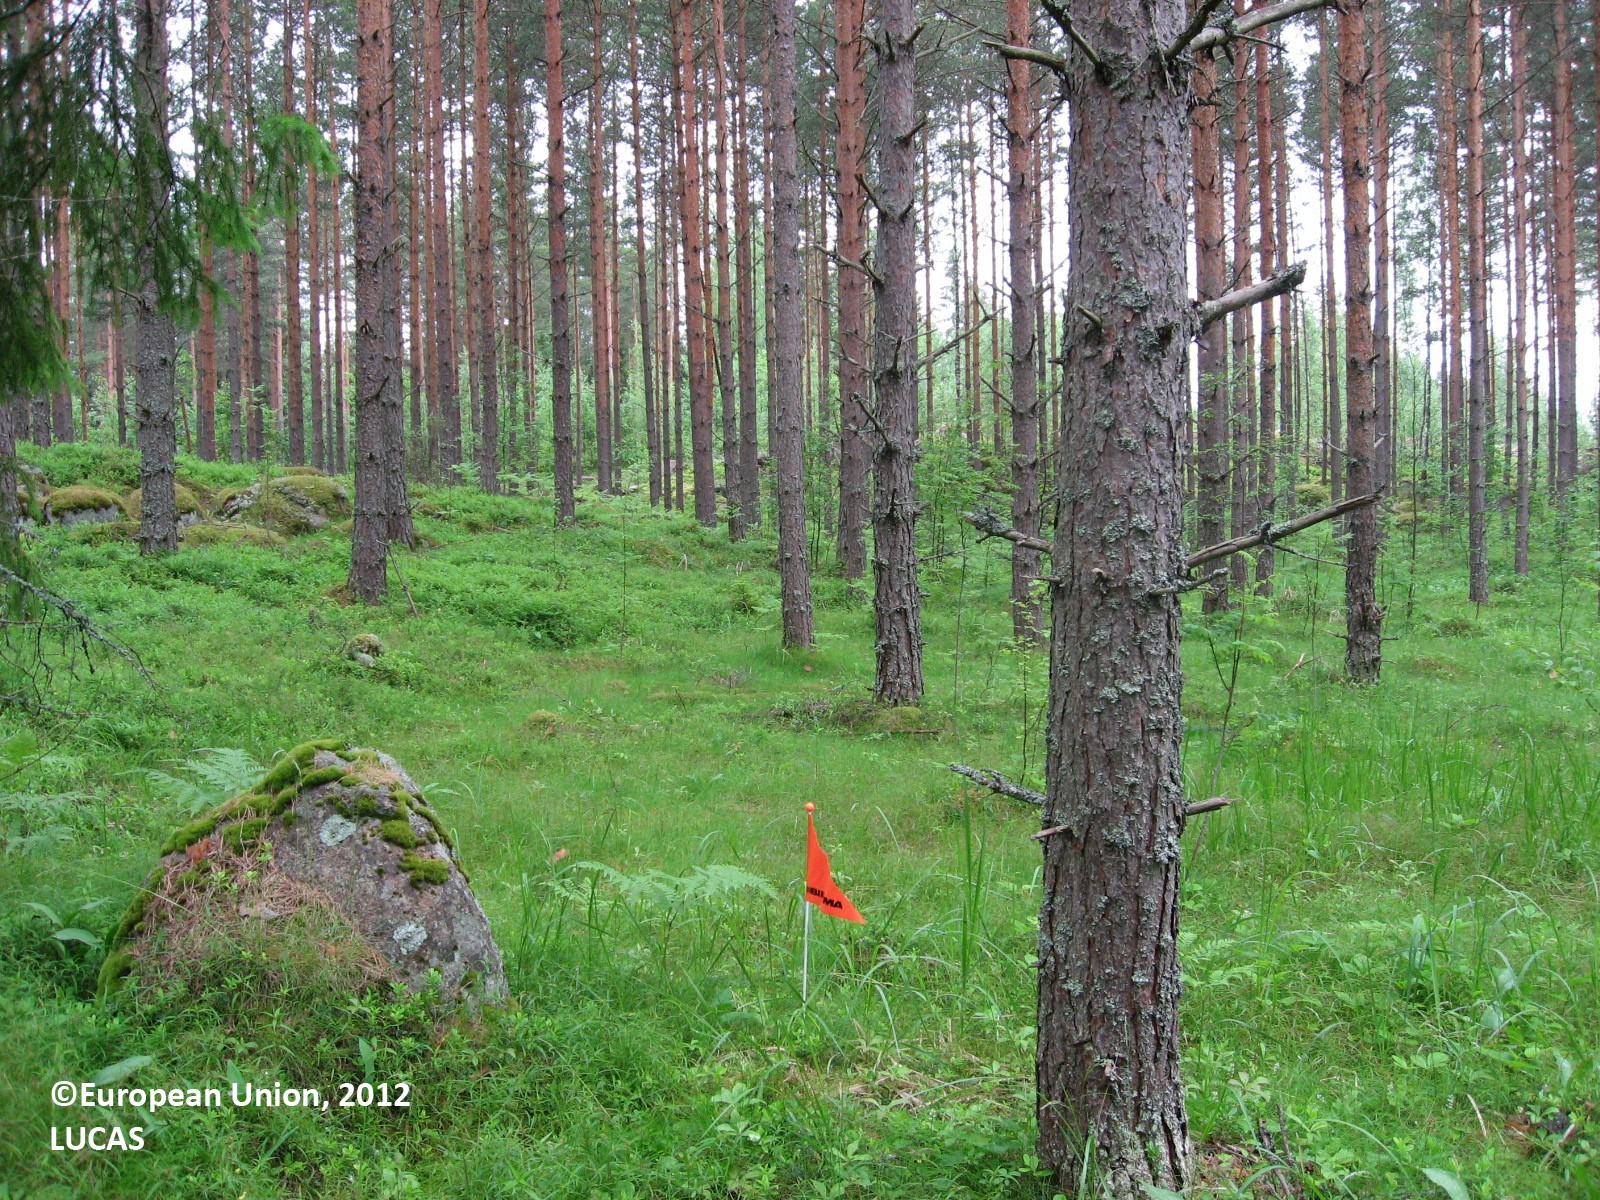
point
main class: Woodland
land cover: Pine dominated coniferous woodland
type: boreal forest
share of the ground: > 75 %
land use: Forestry
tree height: > 5 m
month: June
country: FI
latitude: 60.4825
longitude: 26.2524
